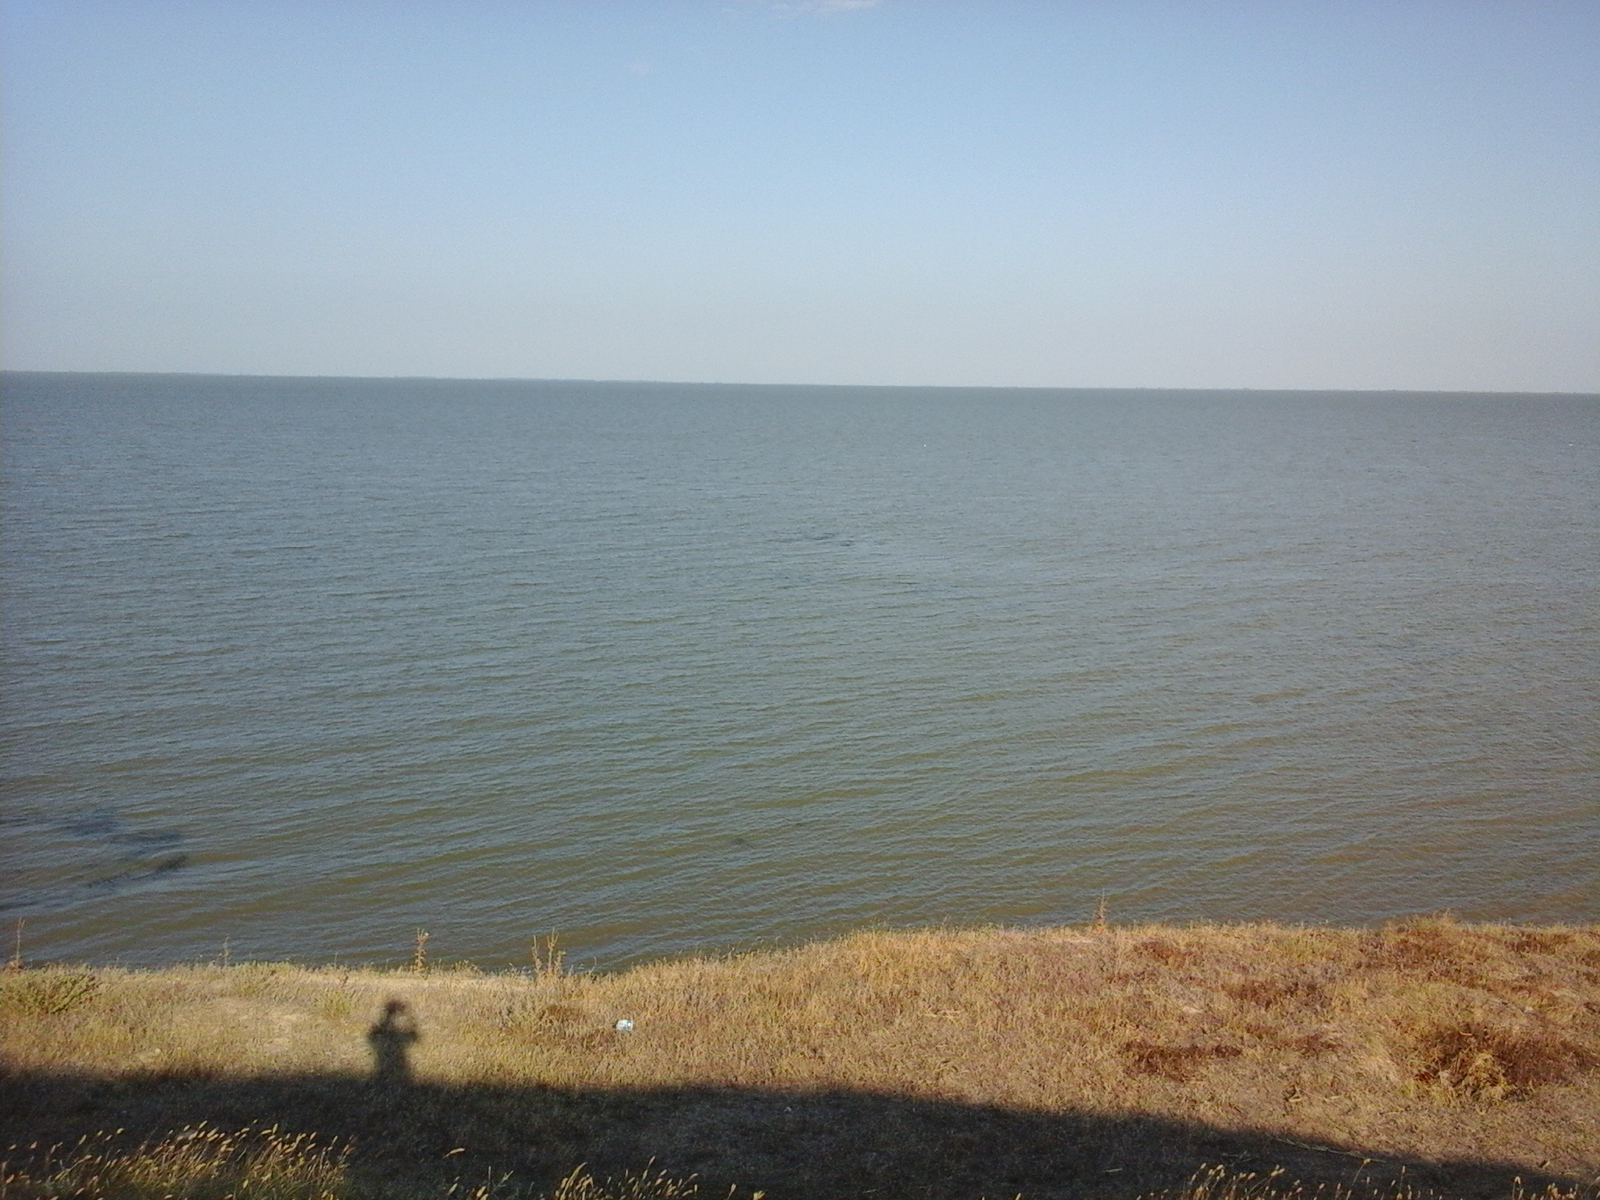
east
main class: Grassland
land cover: Grassland without tree/shrub cover
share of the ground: > 75 %
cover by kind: herbaceous plants 100 %
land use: Agriculture (excluding fallow land and kitchen gardens)
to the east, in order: Grassland without tree/shrub cover; Rocks and stones; Inland fresh water bodies
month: August
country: RO
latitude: 44.8220
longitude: 28.9479
